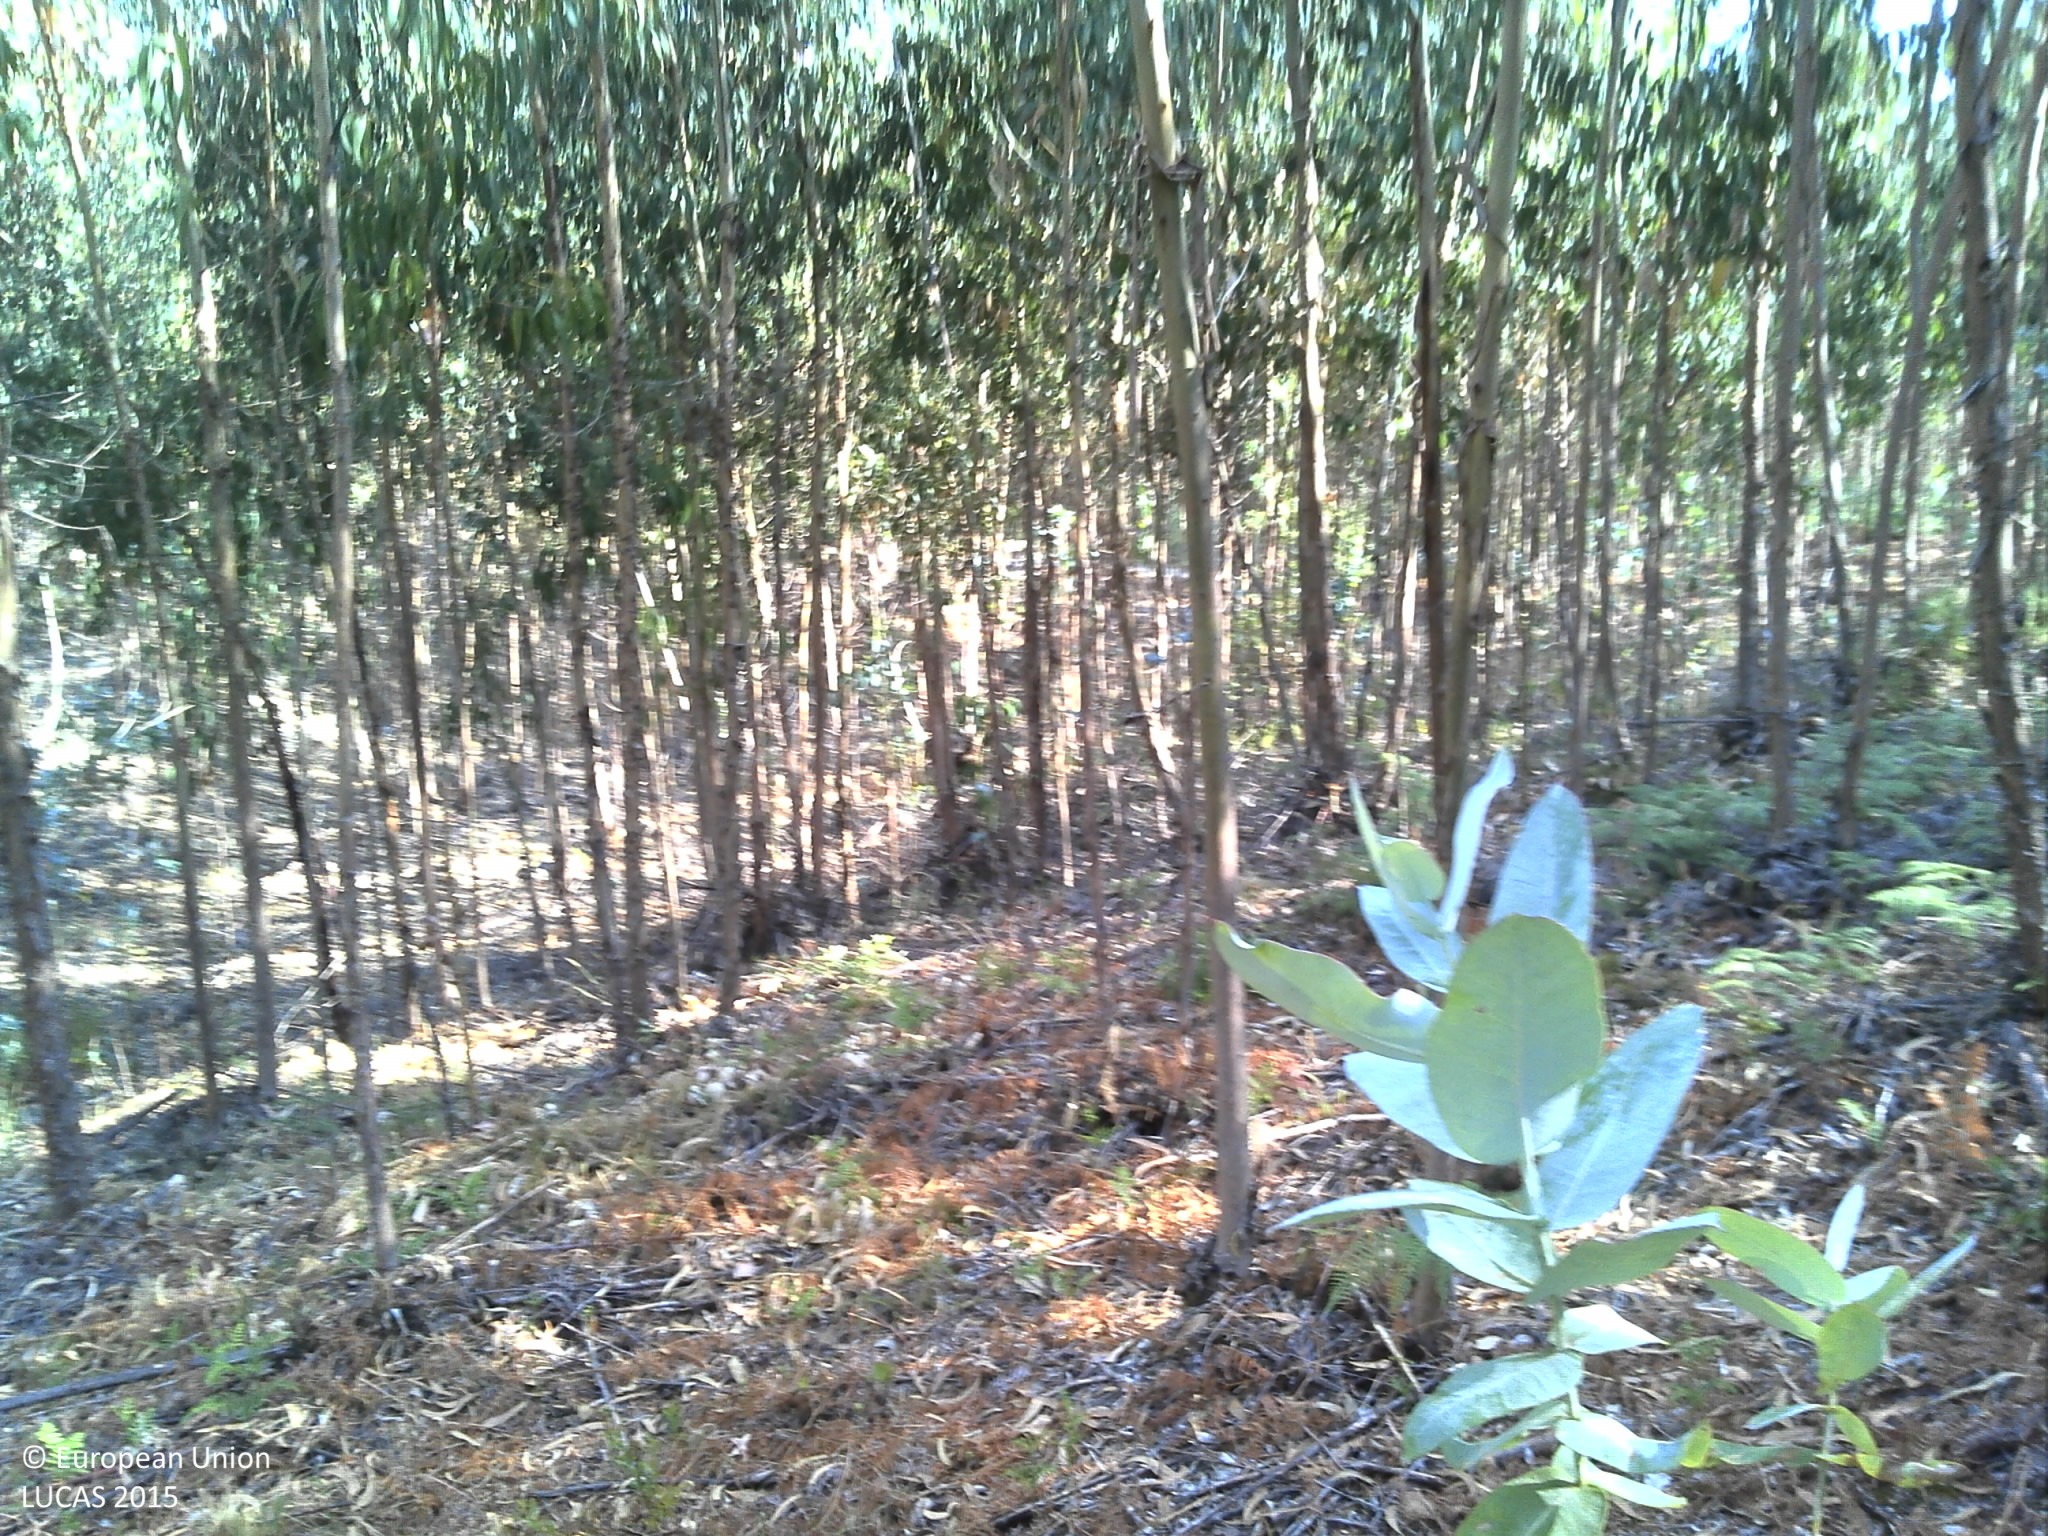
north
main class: Woodland
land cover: Broadleaved woodland
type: exotic forest
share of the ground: > 75 %
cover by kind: broadleaved forest trees 75 %, unconsolidated bare surface 20 %, shrubs 5 %
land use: Forestry
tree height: > 5 m
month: June
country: PT
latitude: 39.1188
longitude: -9.2516
